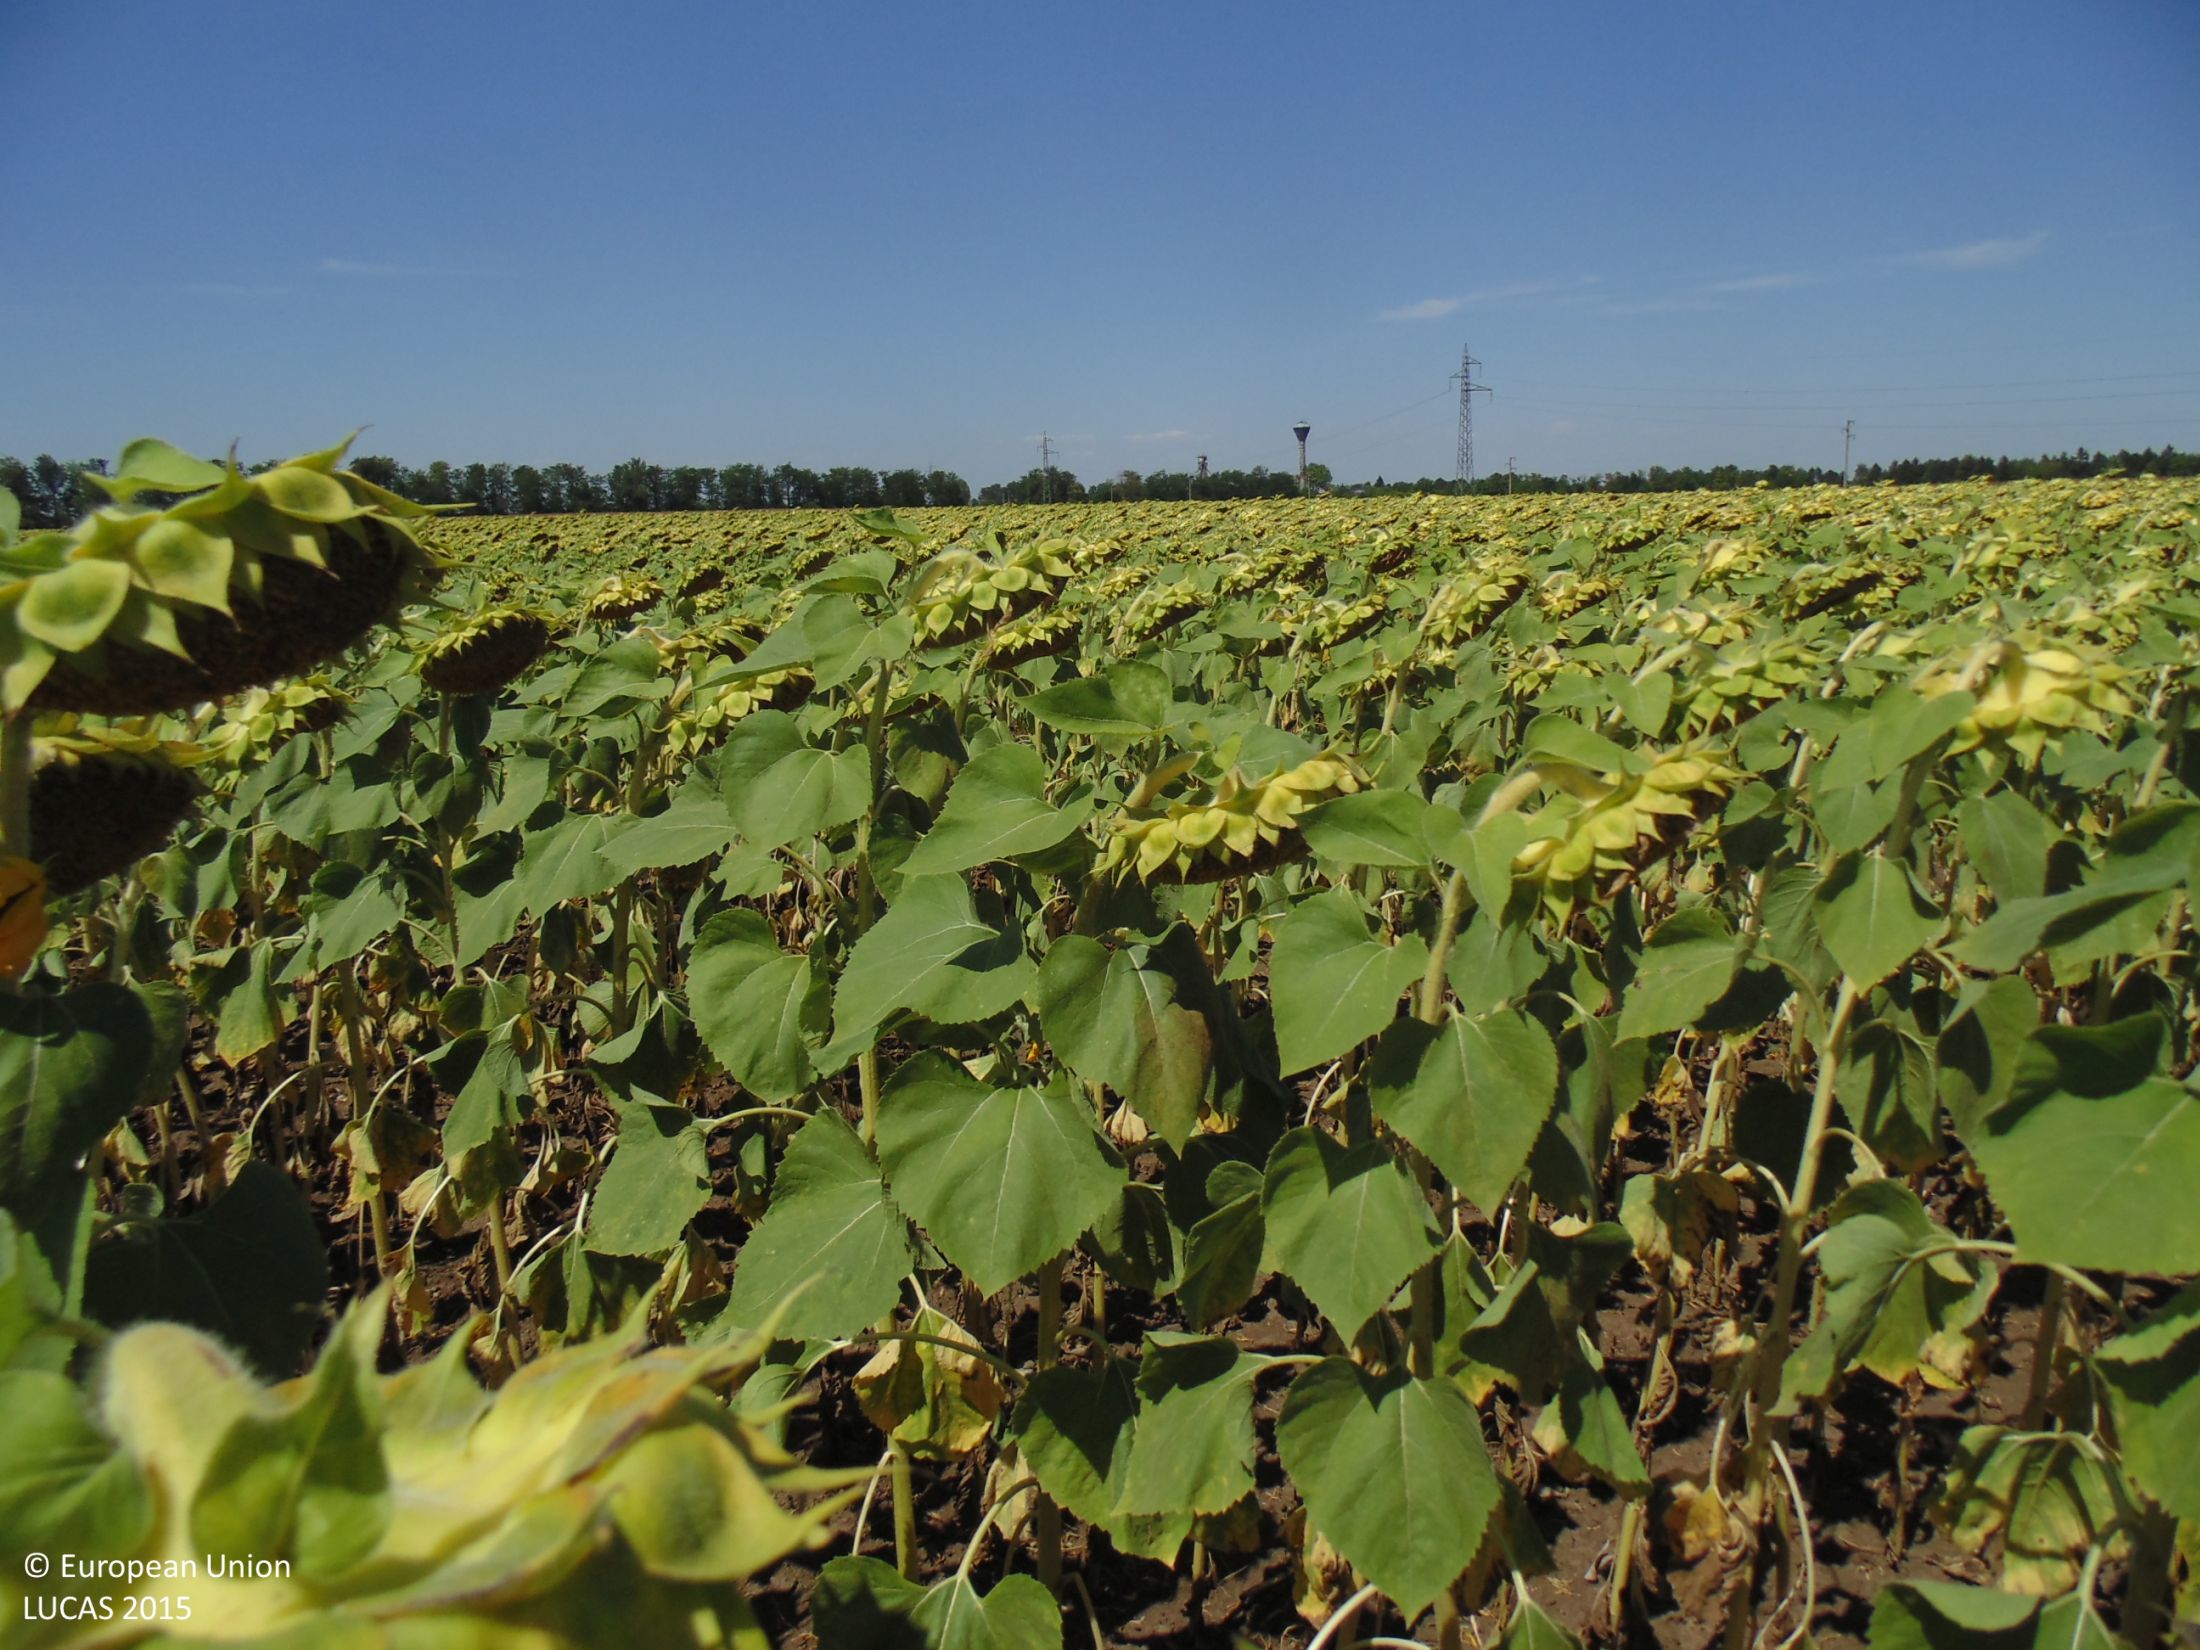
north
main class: Cropland
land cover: Sunflower
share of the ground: > 75 %
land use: Agriculture (excluding fallow land and kitchen gardens)
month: August
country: BG
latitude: 43.7999
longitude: 27.7542
